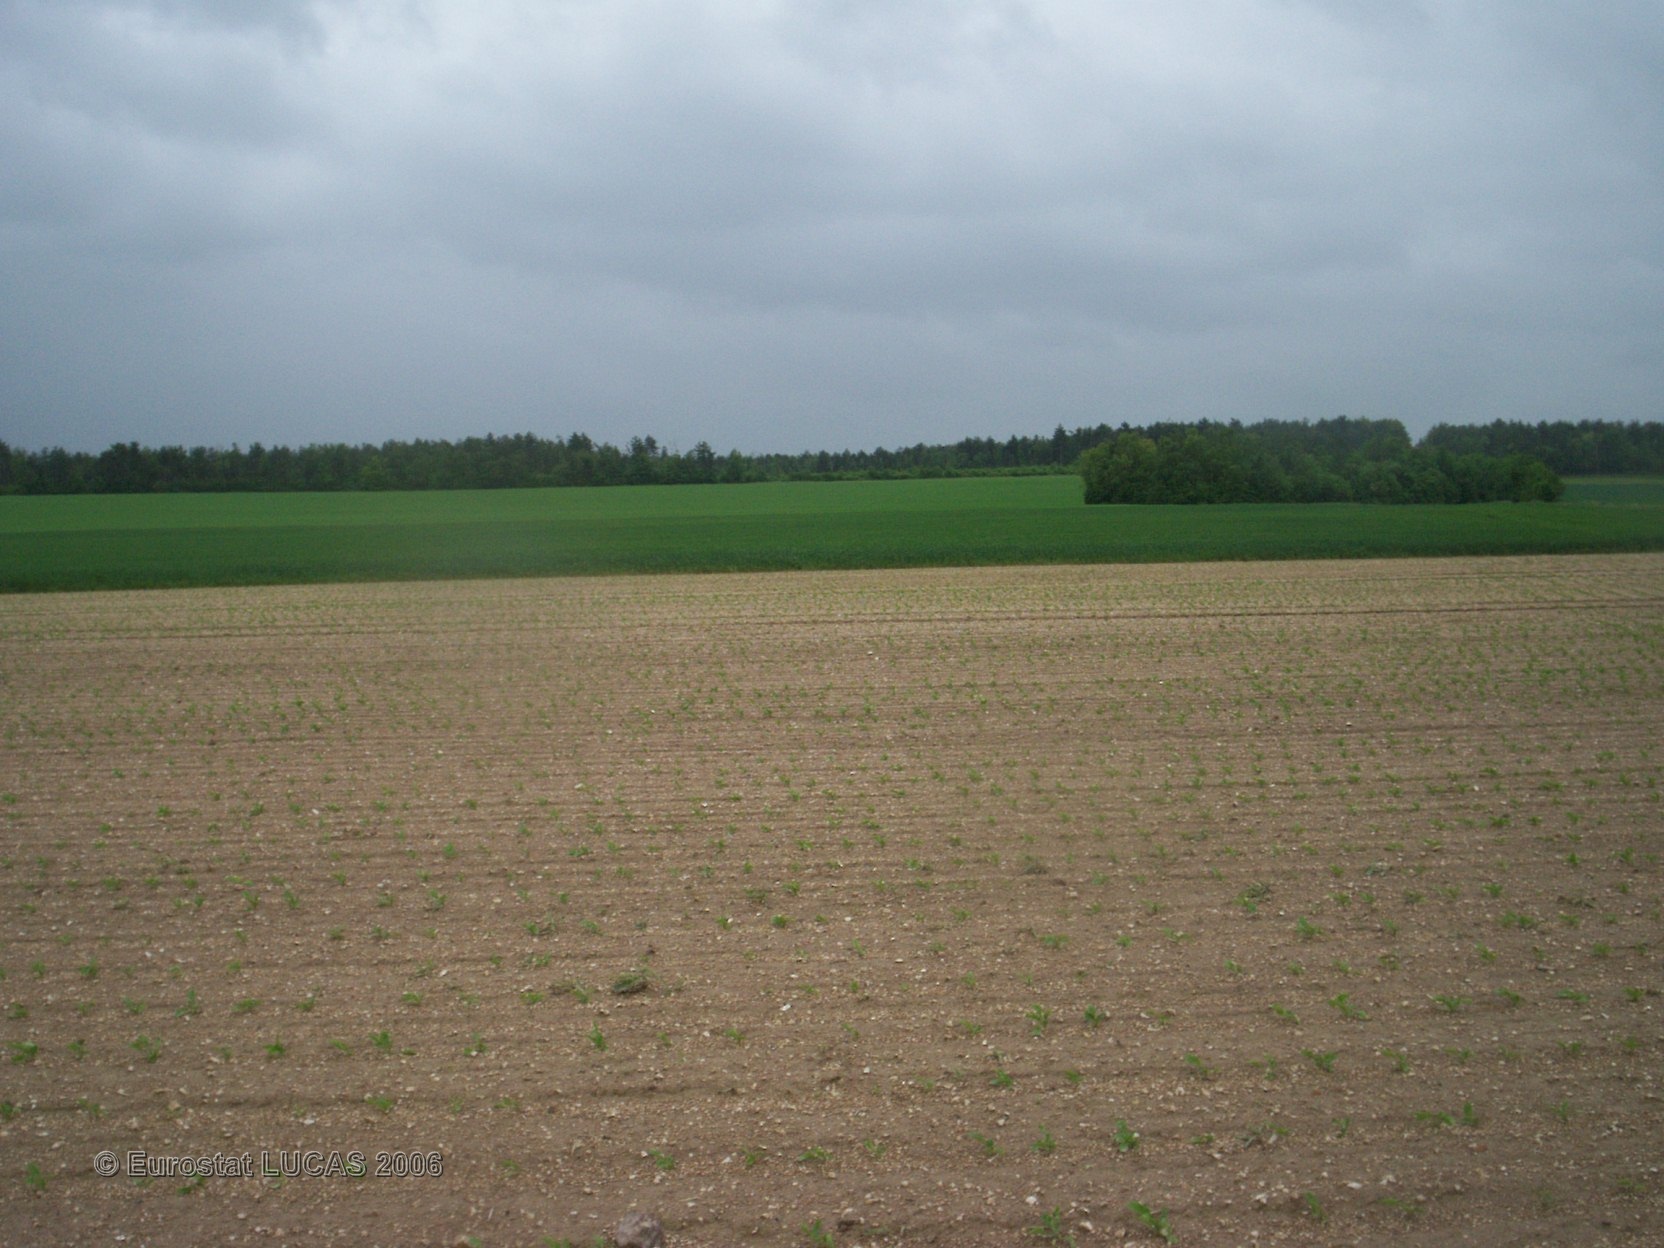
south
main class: Cropland
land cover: Sugar beet
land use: Agriculture (excluding fallow land and kitchen gardens)
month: May
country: FR
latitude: 49.3764
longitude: 4.3351
